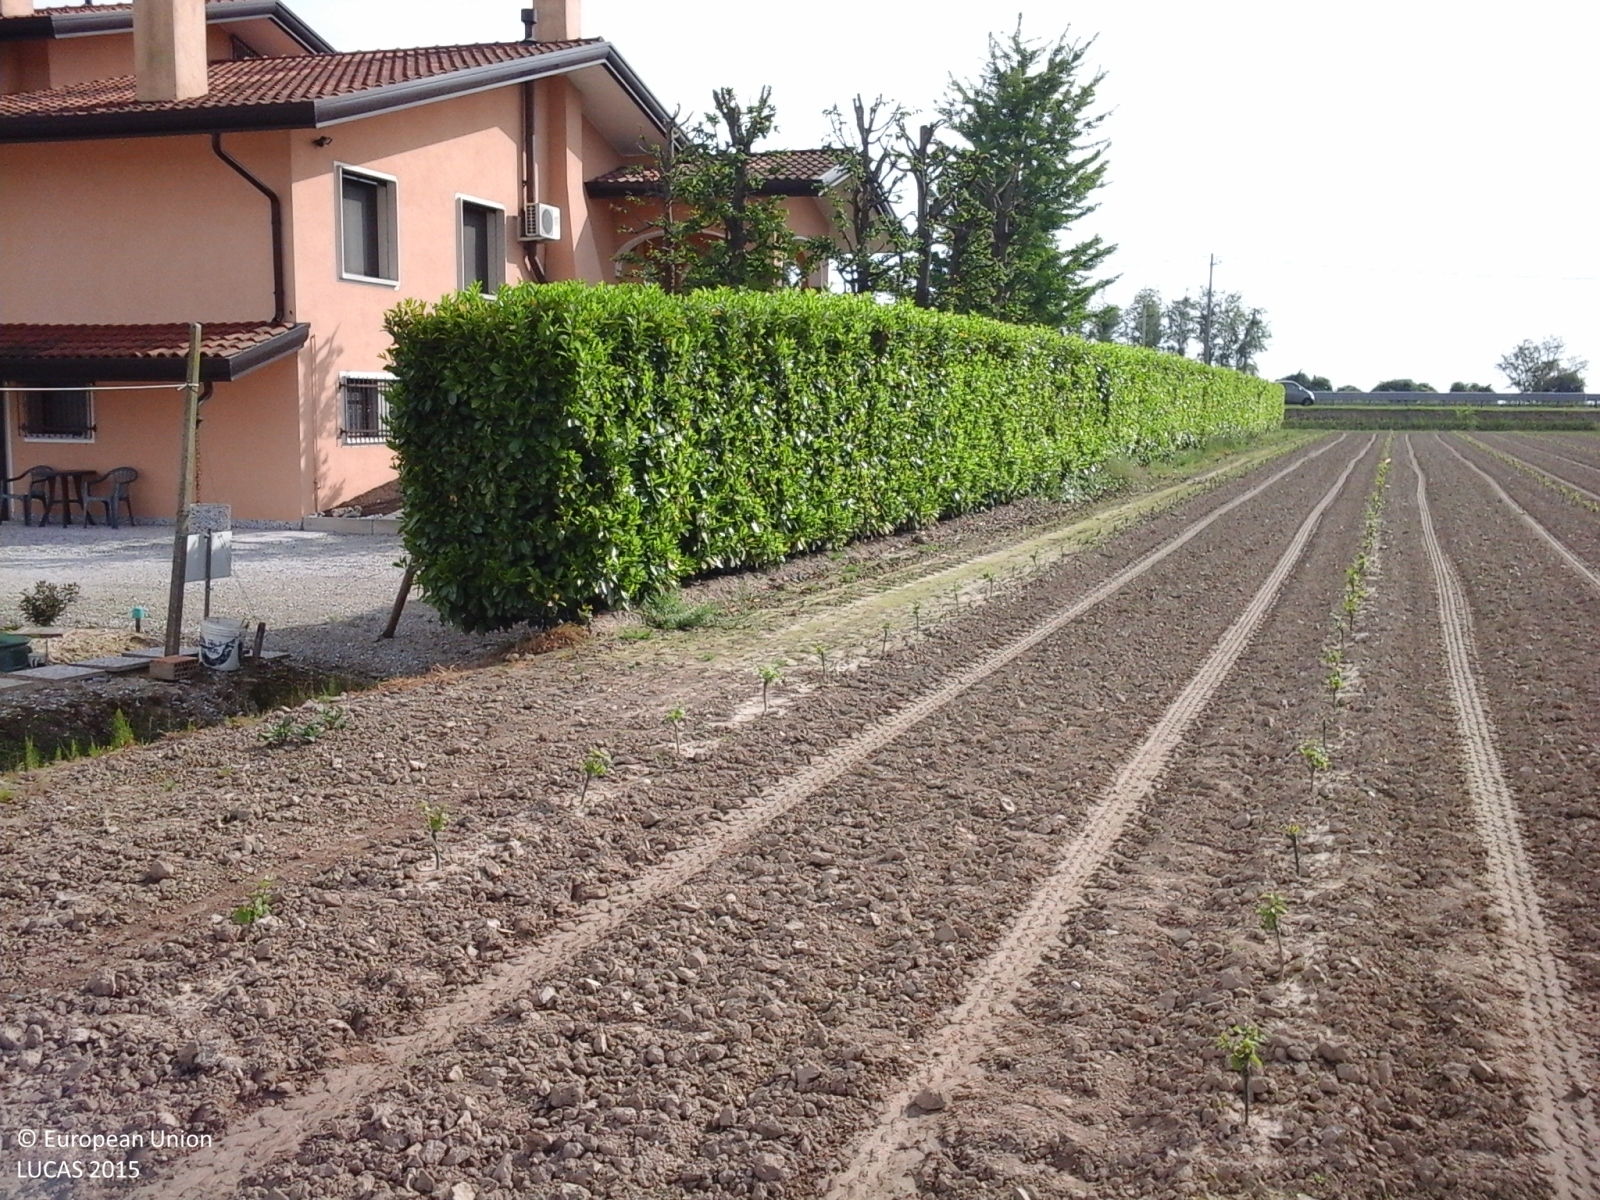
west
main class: Cropland
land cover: Vineyards
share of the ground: < 10 %
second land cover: Other bare soil
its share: > 75 %
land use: Agriculture (excluding fallow land and kitchen gardens)
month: May
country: IT
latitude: 45.5633
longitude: 12.5714
